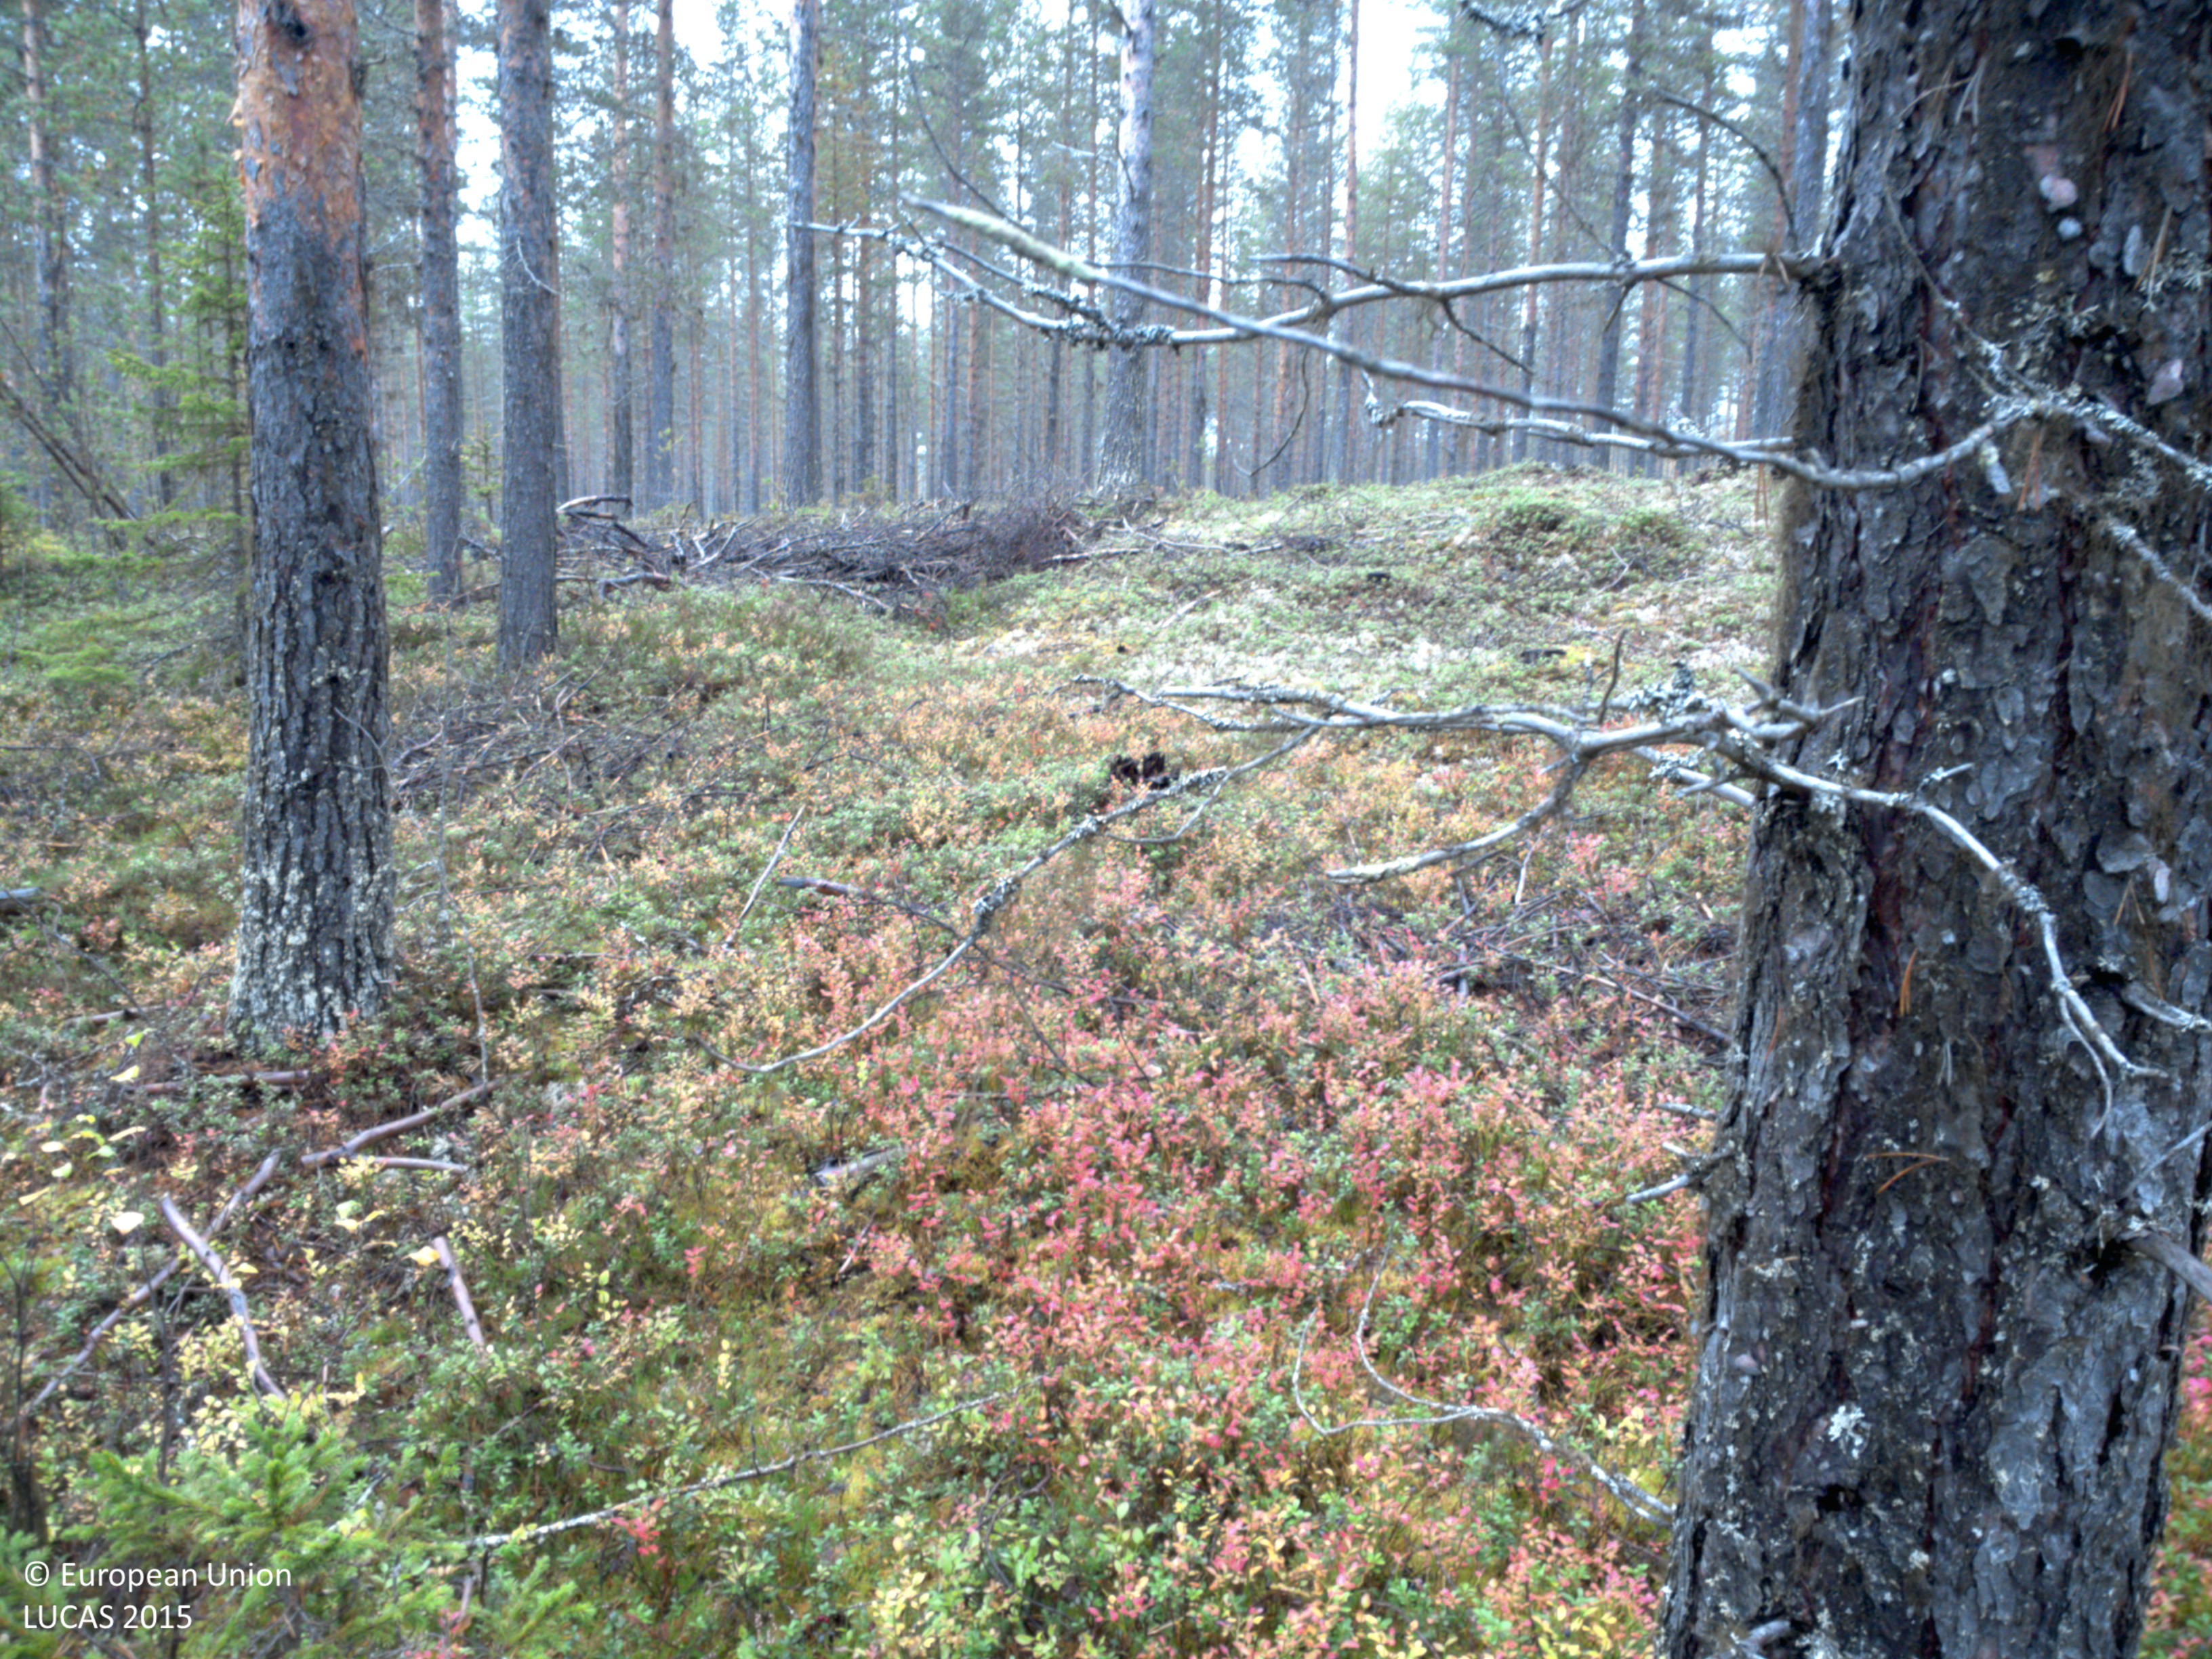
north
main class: Woodland
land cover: Pine dominated coniferous woodland
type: boreal forest
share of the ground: 50 - 75 %
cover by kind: coniferous forest trees 55 %, shrubs 35 %, lichens and mosses 10 %
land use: Forestry
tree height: > 5 m
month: September
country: SE
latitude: 64.8000
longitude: 18.9551
